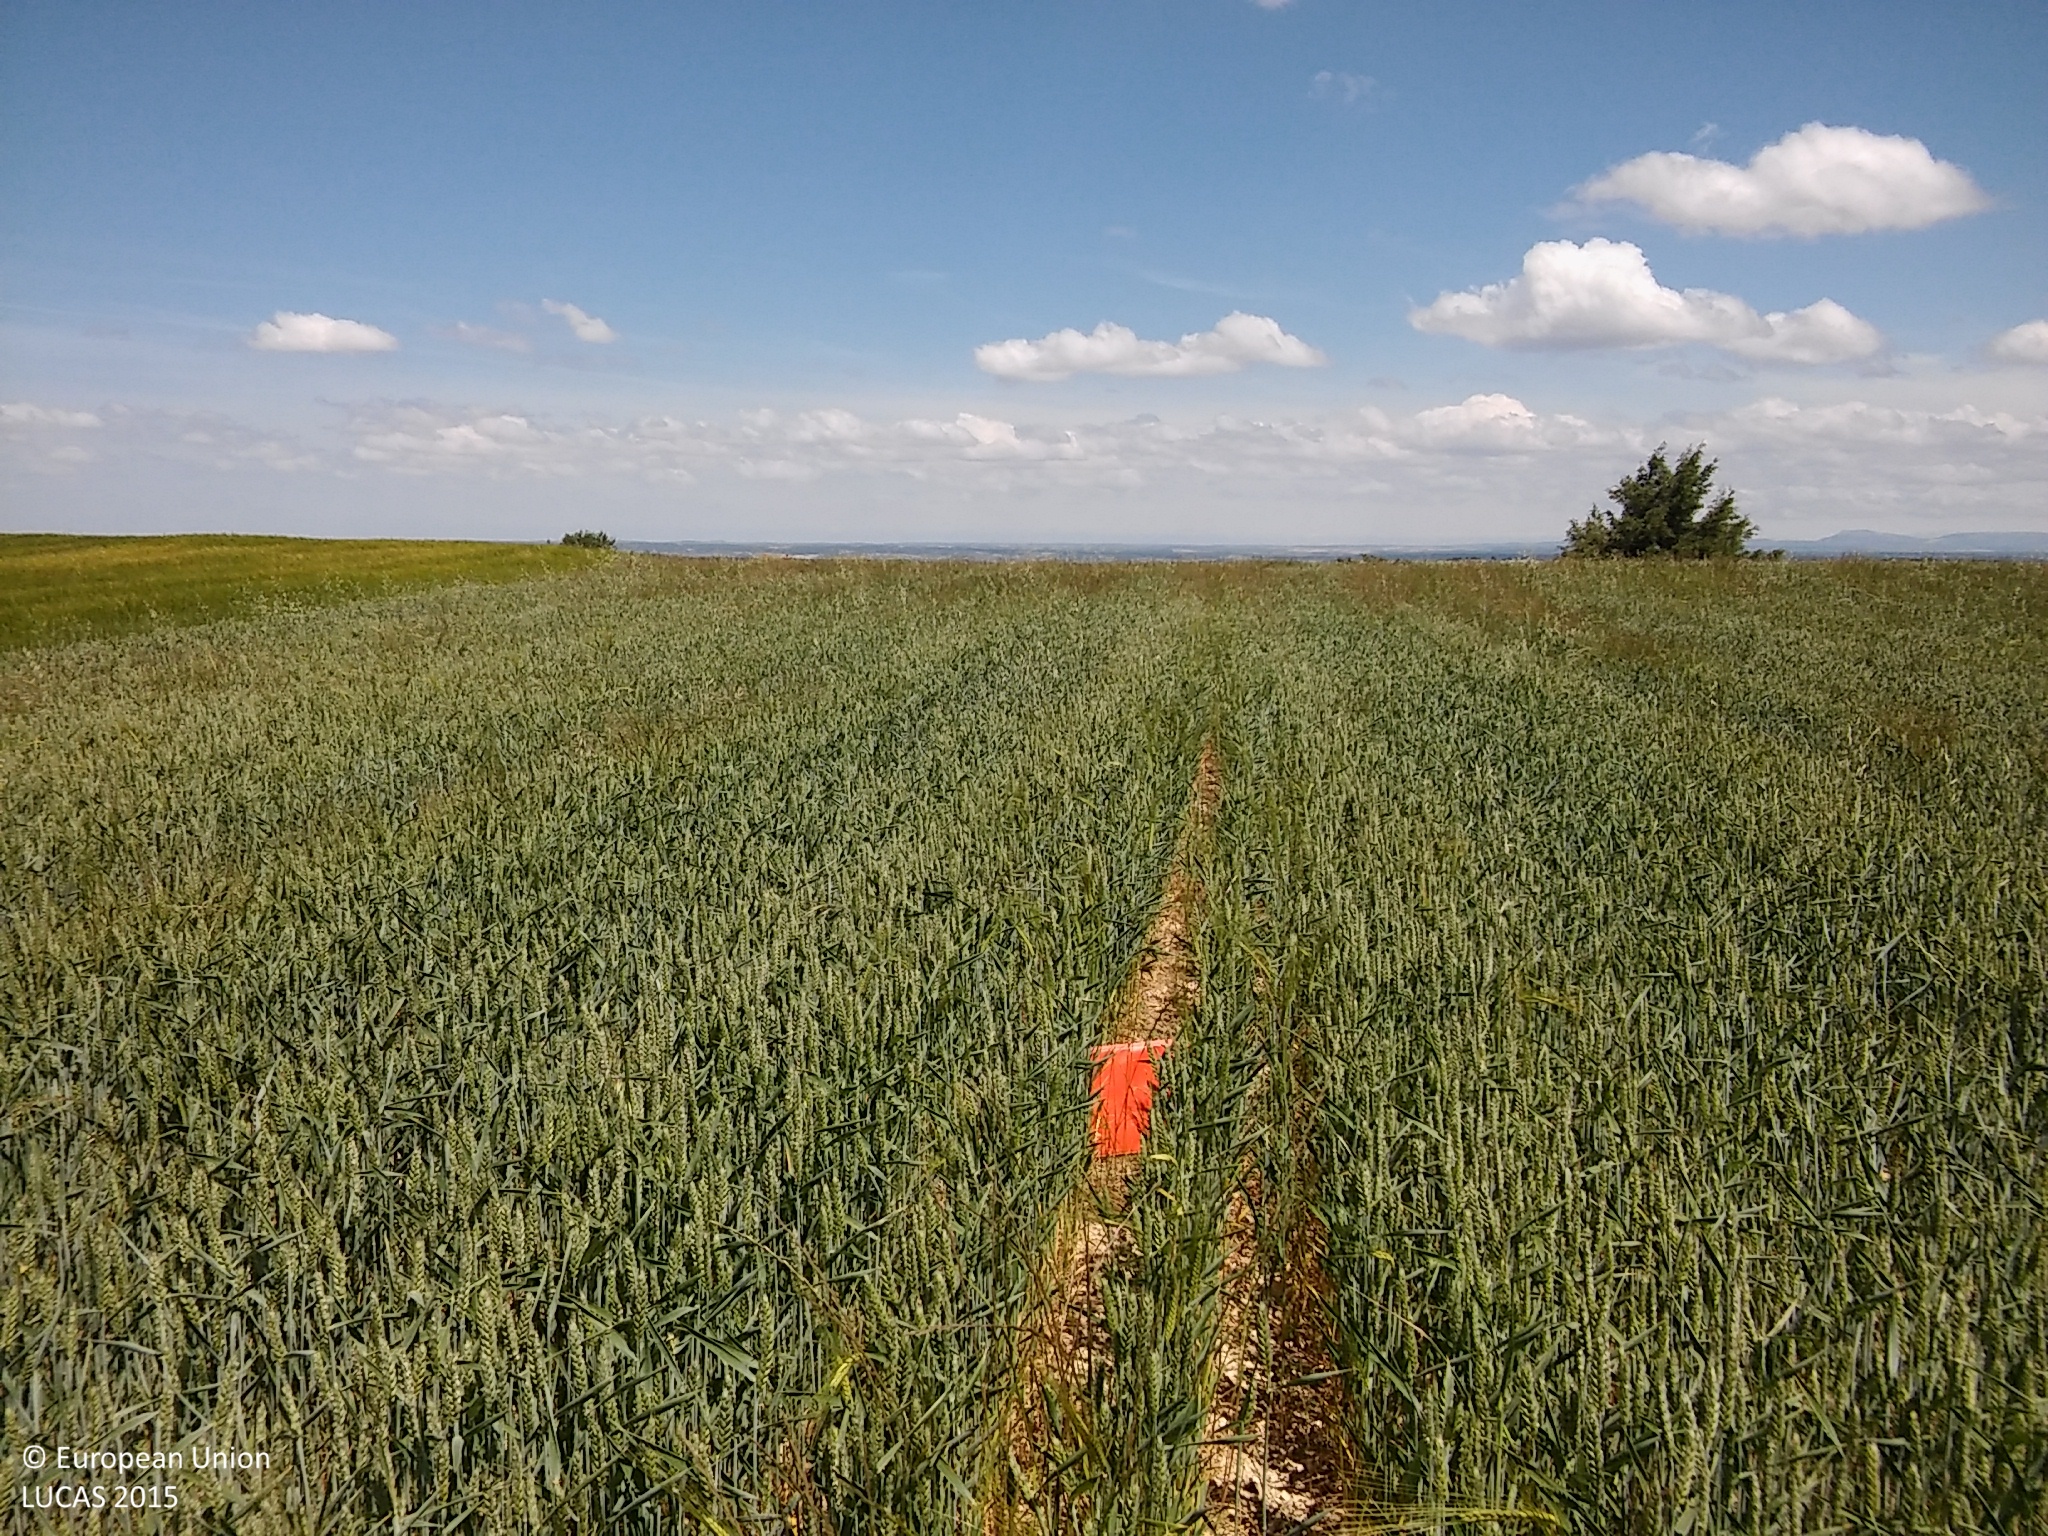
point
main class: Cropland
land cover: Common wheat
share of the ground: > 75 %
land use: Agriculture (excluding fallow land and kitchen gardens)
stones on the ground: 25 - 50 %
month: May
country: ES
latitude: 41.5800
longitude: -3.6405
